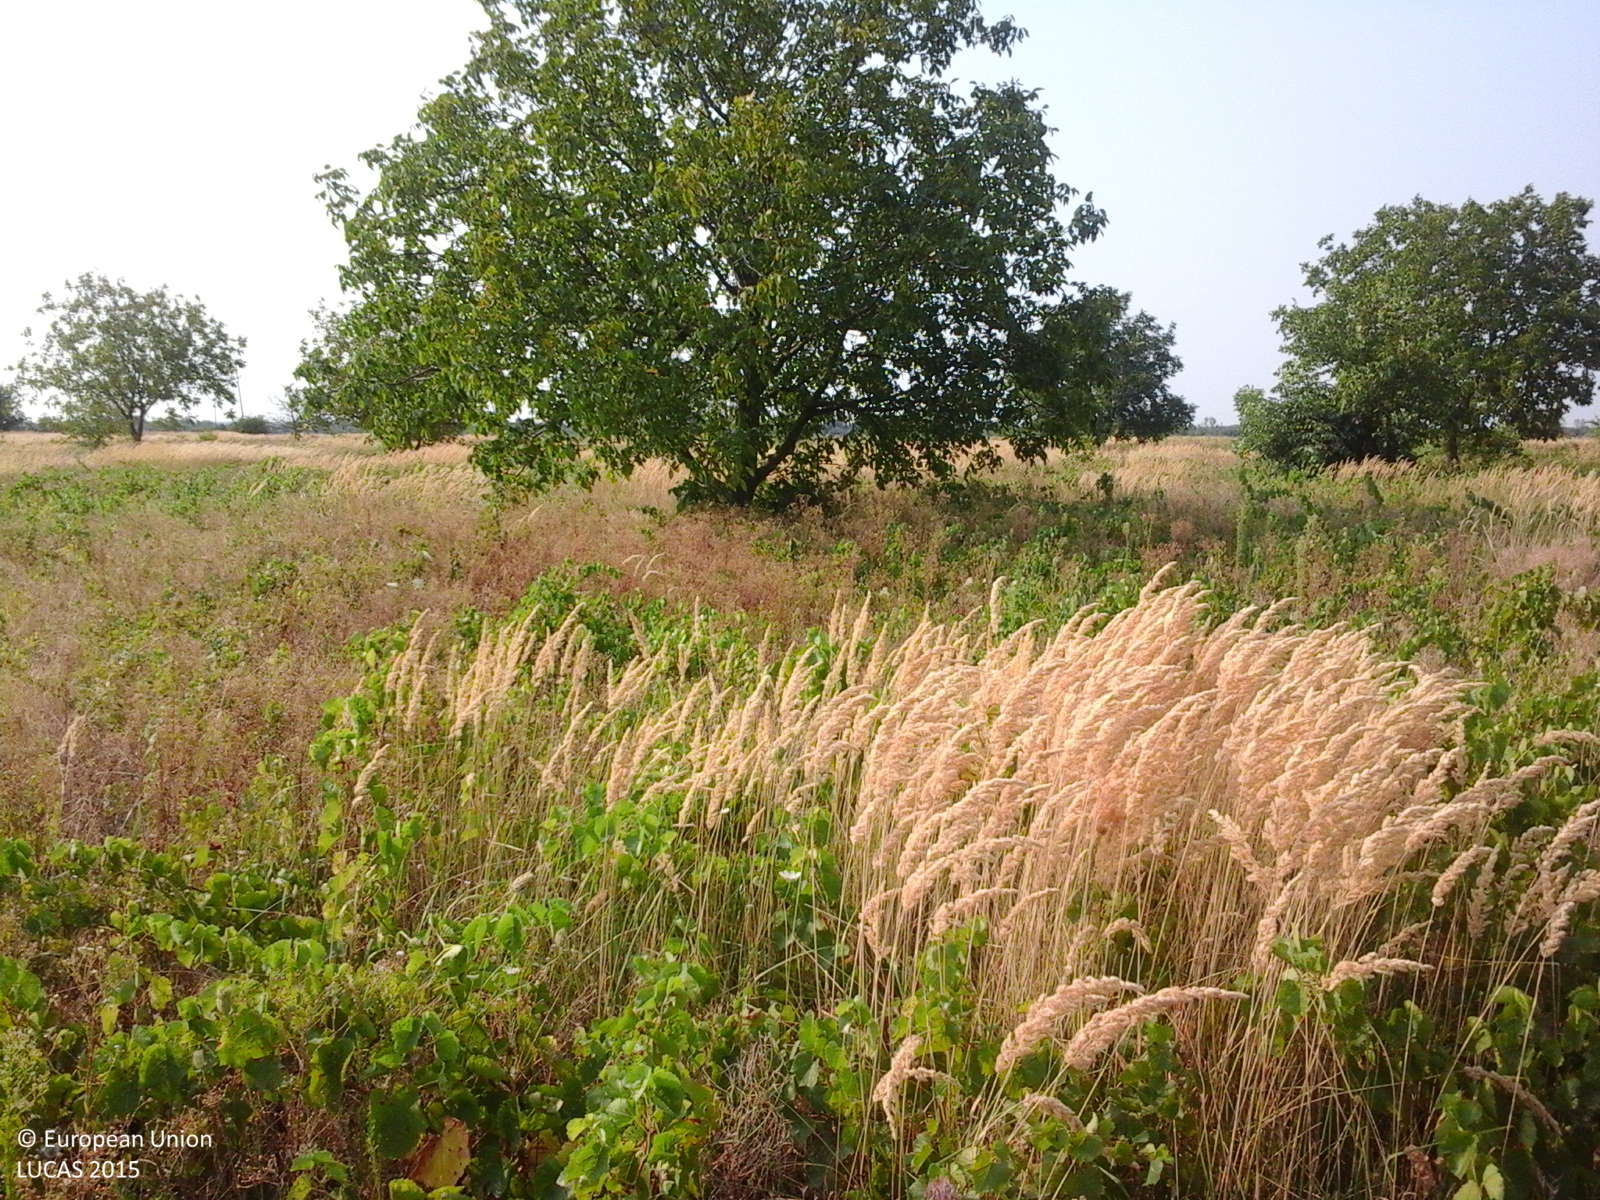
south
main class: Cropland
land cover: Vineyards
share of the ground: 25 - 50 %
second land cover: Spontaneously vegetated surfaces
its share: > 75 %
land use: Agriculture (excluding fallow land and kitchen gardens)
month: August
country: RO
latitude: 44.2603
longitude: 23.4150
